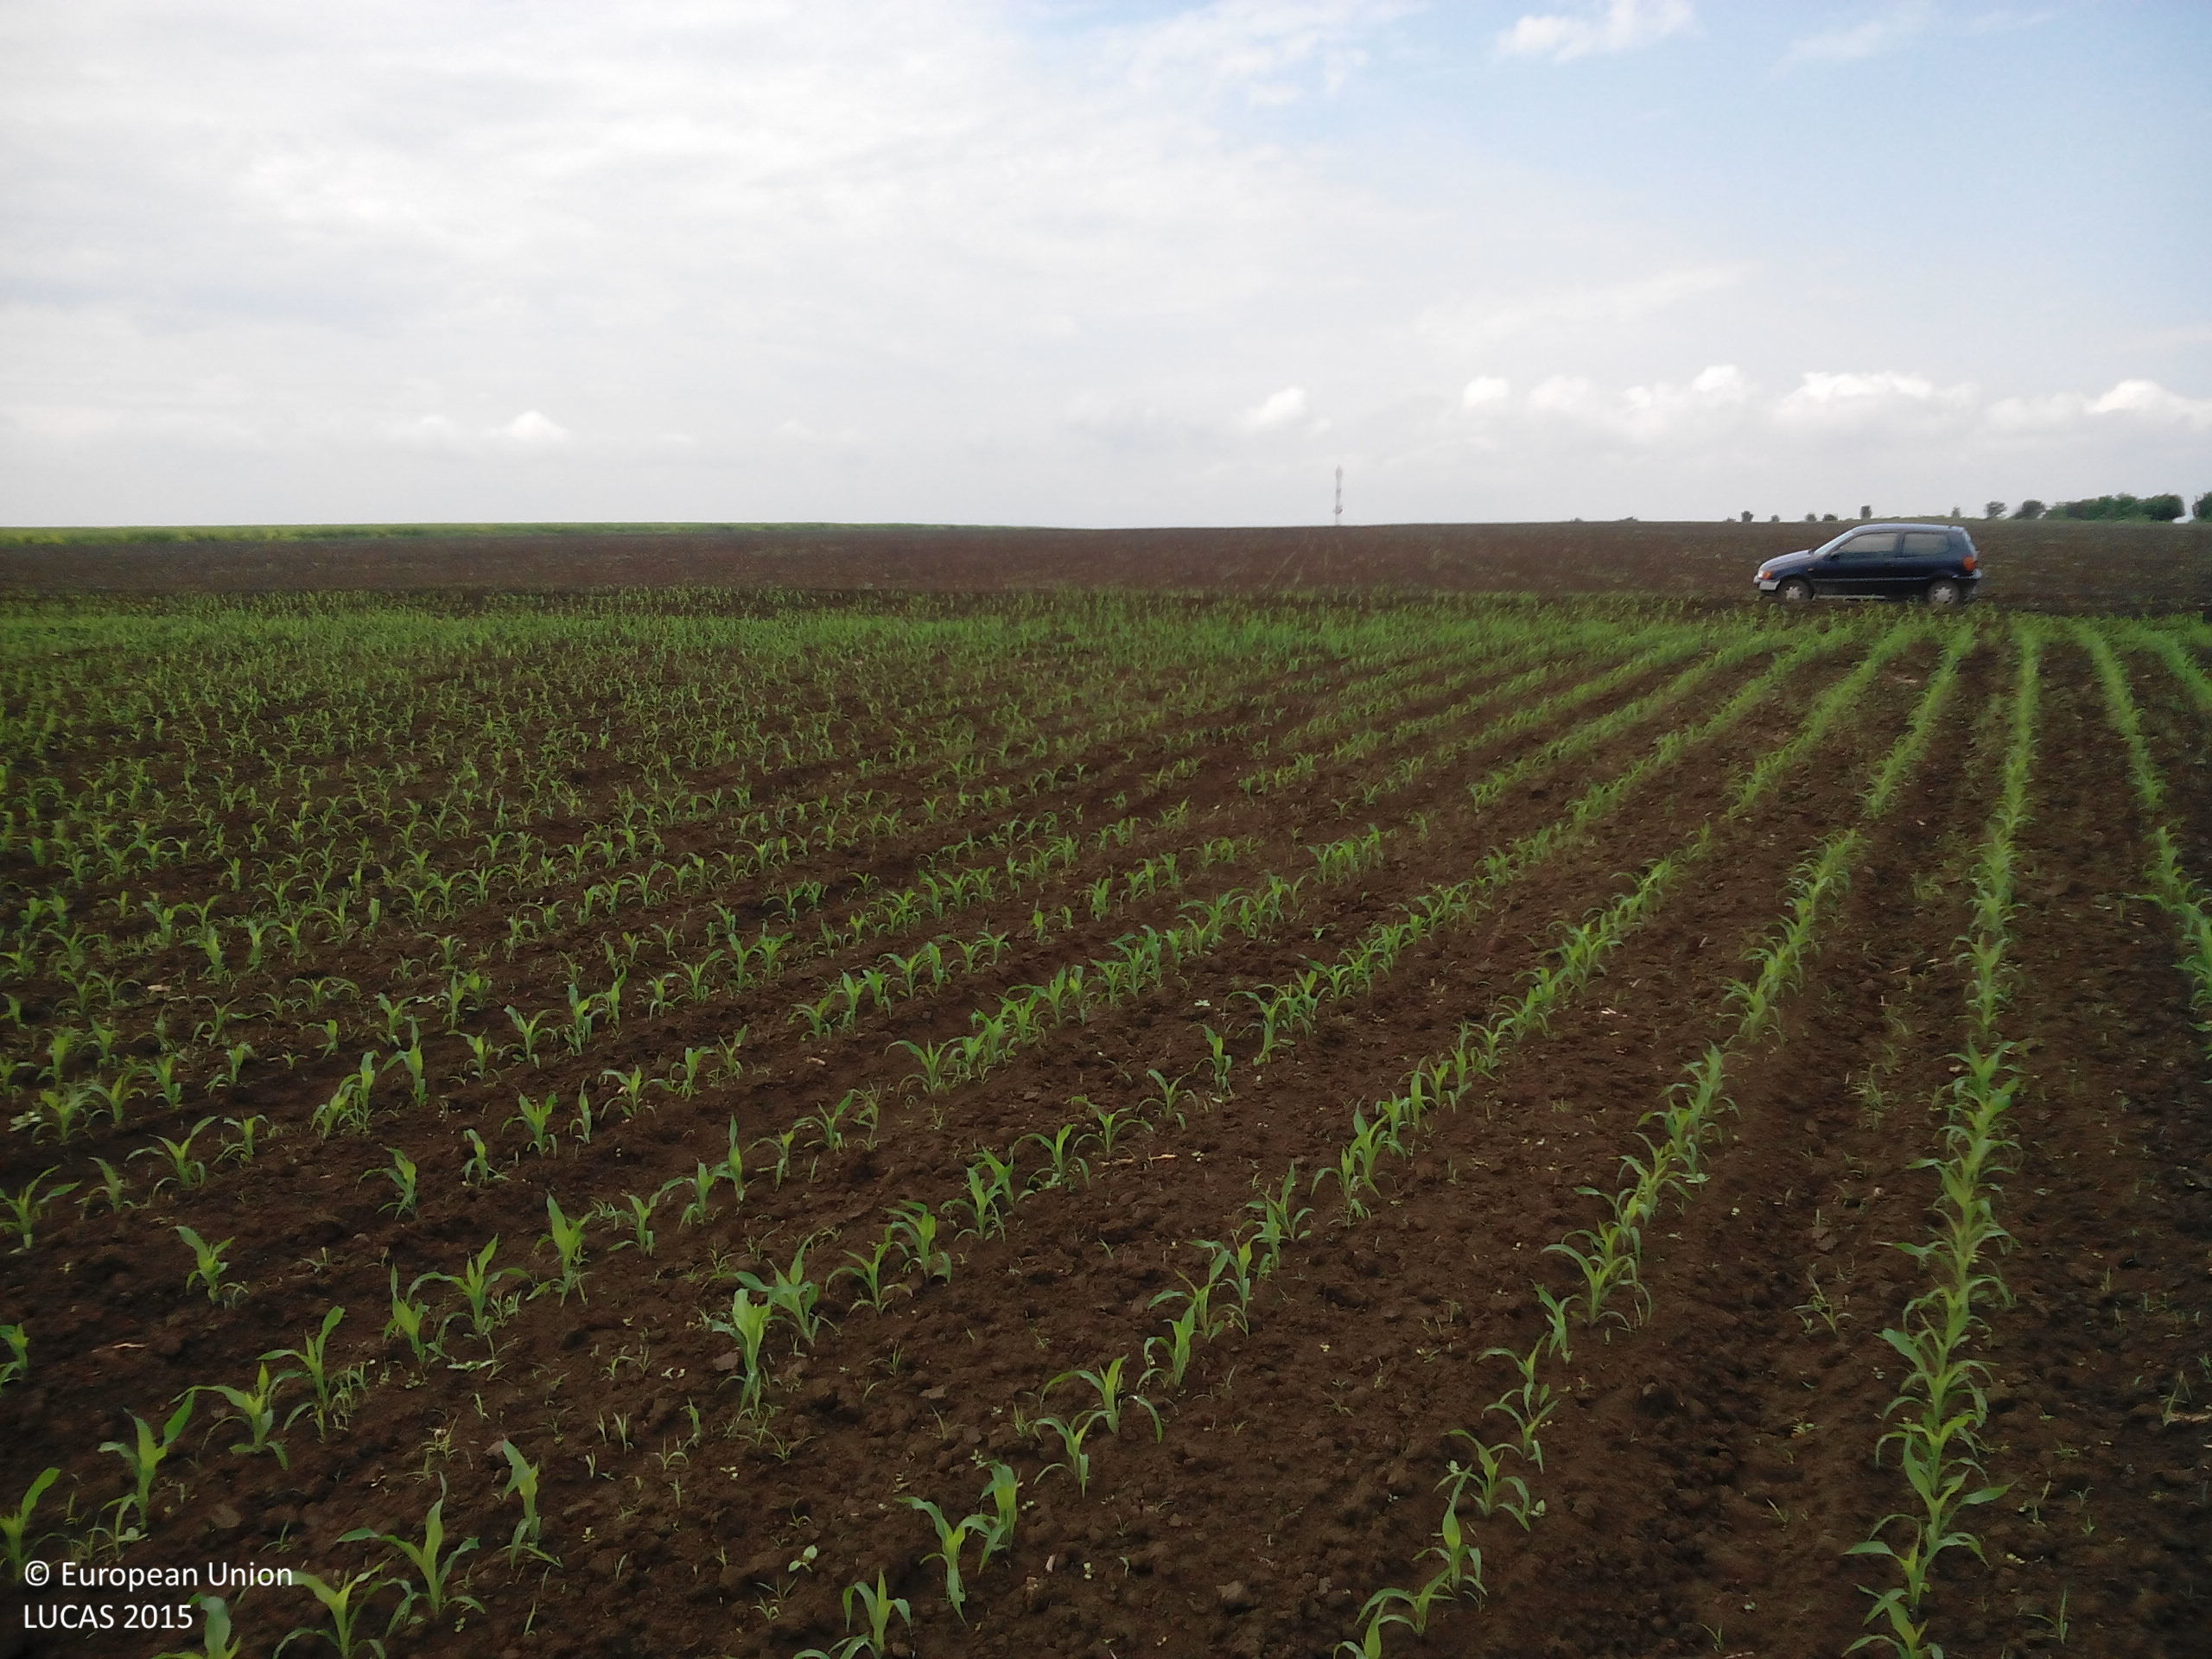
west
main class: Cropland
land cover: Maize
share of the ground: 10 - 25 %
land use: Agriculture (excluding fallow land and kitchen gardens)
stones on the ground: < 10 %
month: May
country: BG
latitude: 43.6141
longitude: 23.7414
